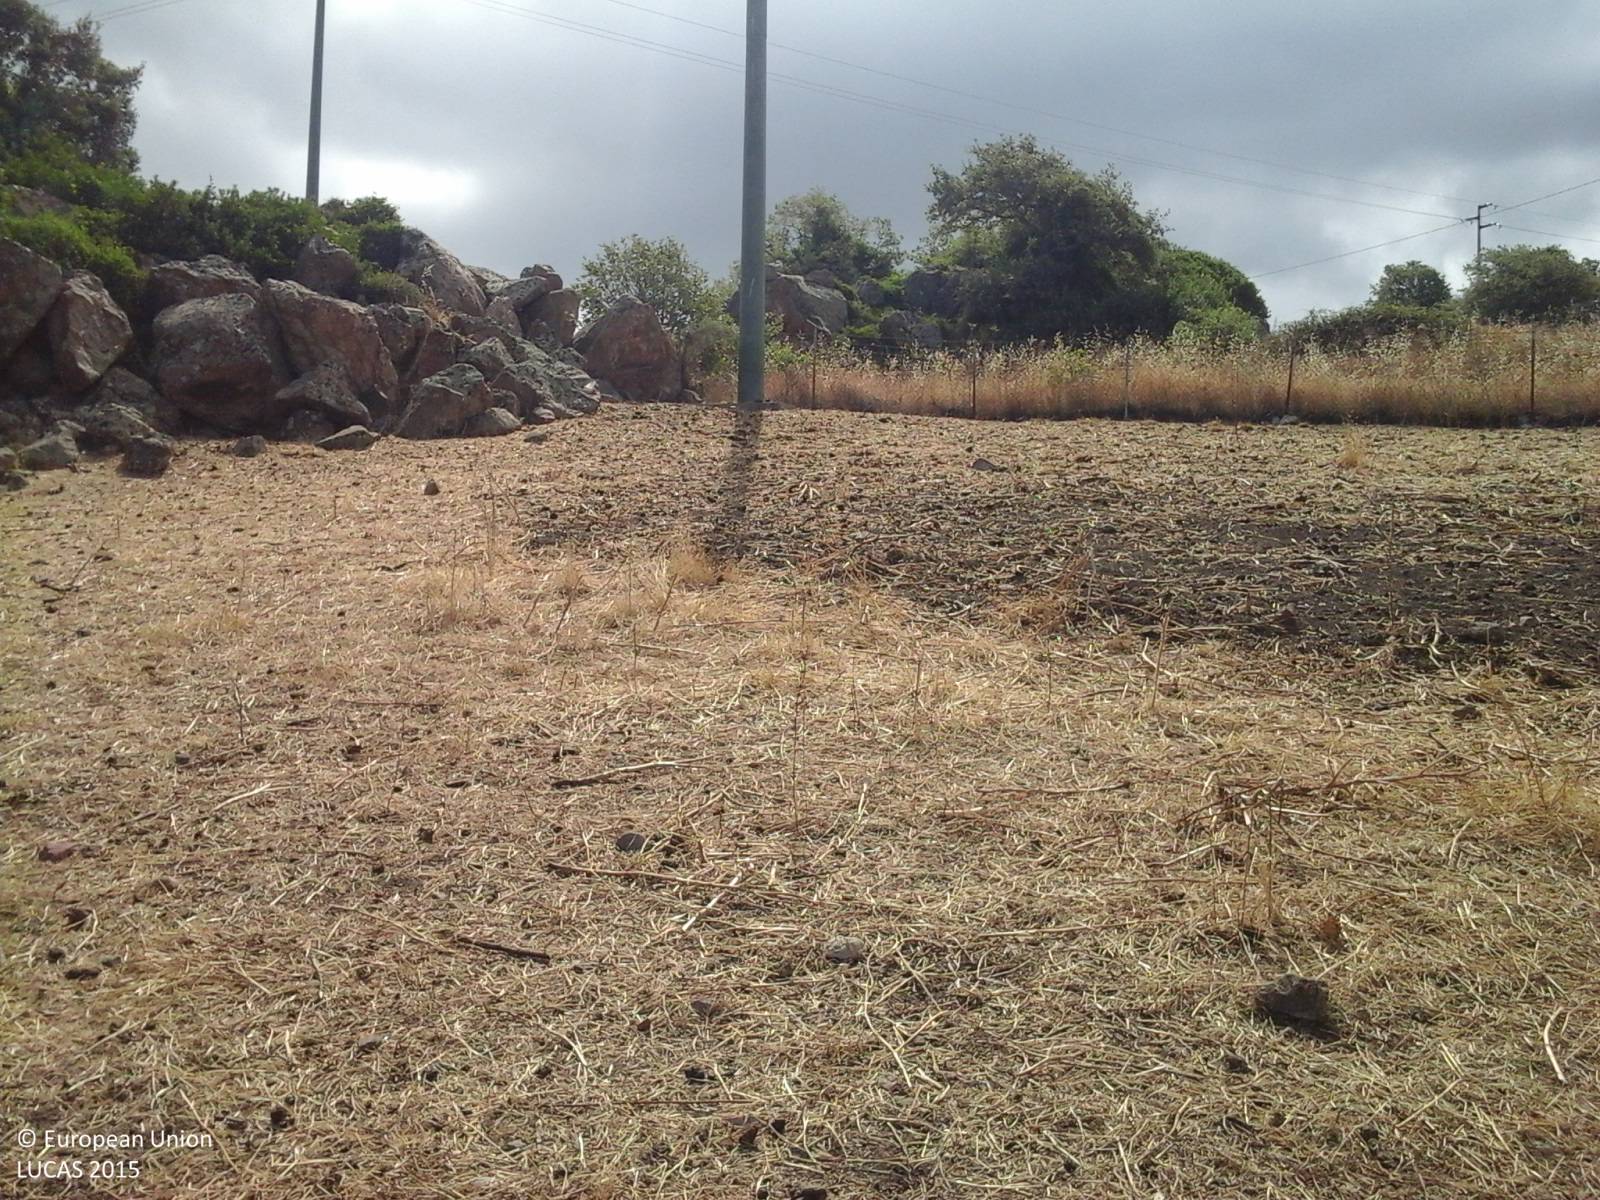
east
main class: Grassland
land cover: Grassland without tree/shrub cover
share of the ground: < 10 %
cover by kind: herbaceous plants 100 %
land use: Agriculture (excluding fallow land and kitchen gardens)
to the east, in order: Grassland without tree/shrub cover; Shrubland without tree cover; Electric lines; Rock outcrops; Grassland without tree/shrub cover; Paved roads, cycling and walking lanes; Grassland without tree/shrub cover; Fences; Abandoned hedges; Electric lines; Grassland without tree/shrub cover; Electric lines; Grassland without tree/shrub cover; Single bushes/trees; Grassland without tree/shrub cover; Managed hedges; Grassland without tree/shrub cover; Dry stone walls; Shrubland with sparse tree cover; Fences; Grass margins; Paved roads, cycling and walking lanes; Grass margins; Fences; Dry stone walls; Abandoned hedges; Grassland without tree/shrub cover
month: July
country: IT
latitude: 40.4966
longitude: 8.9082
